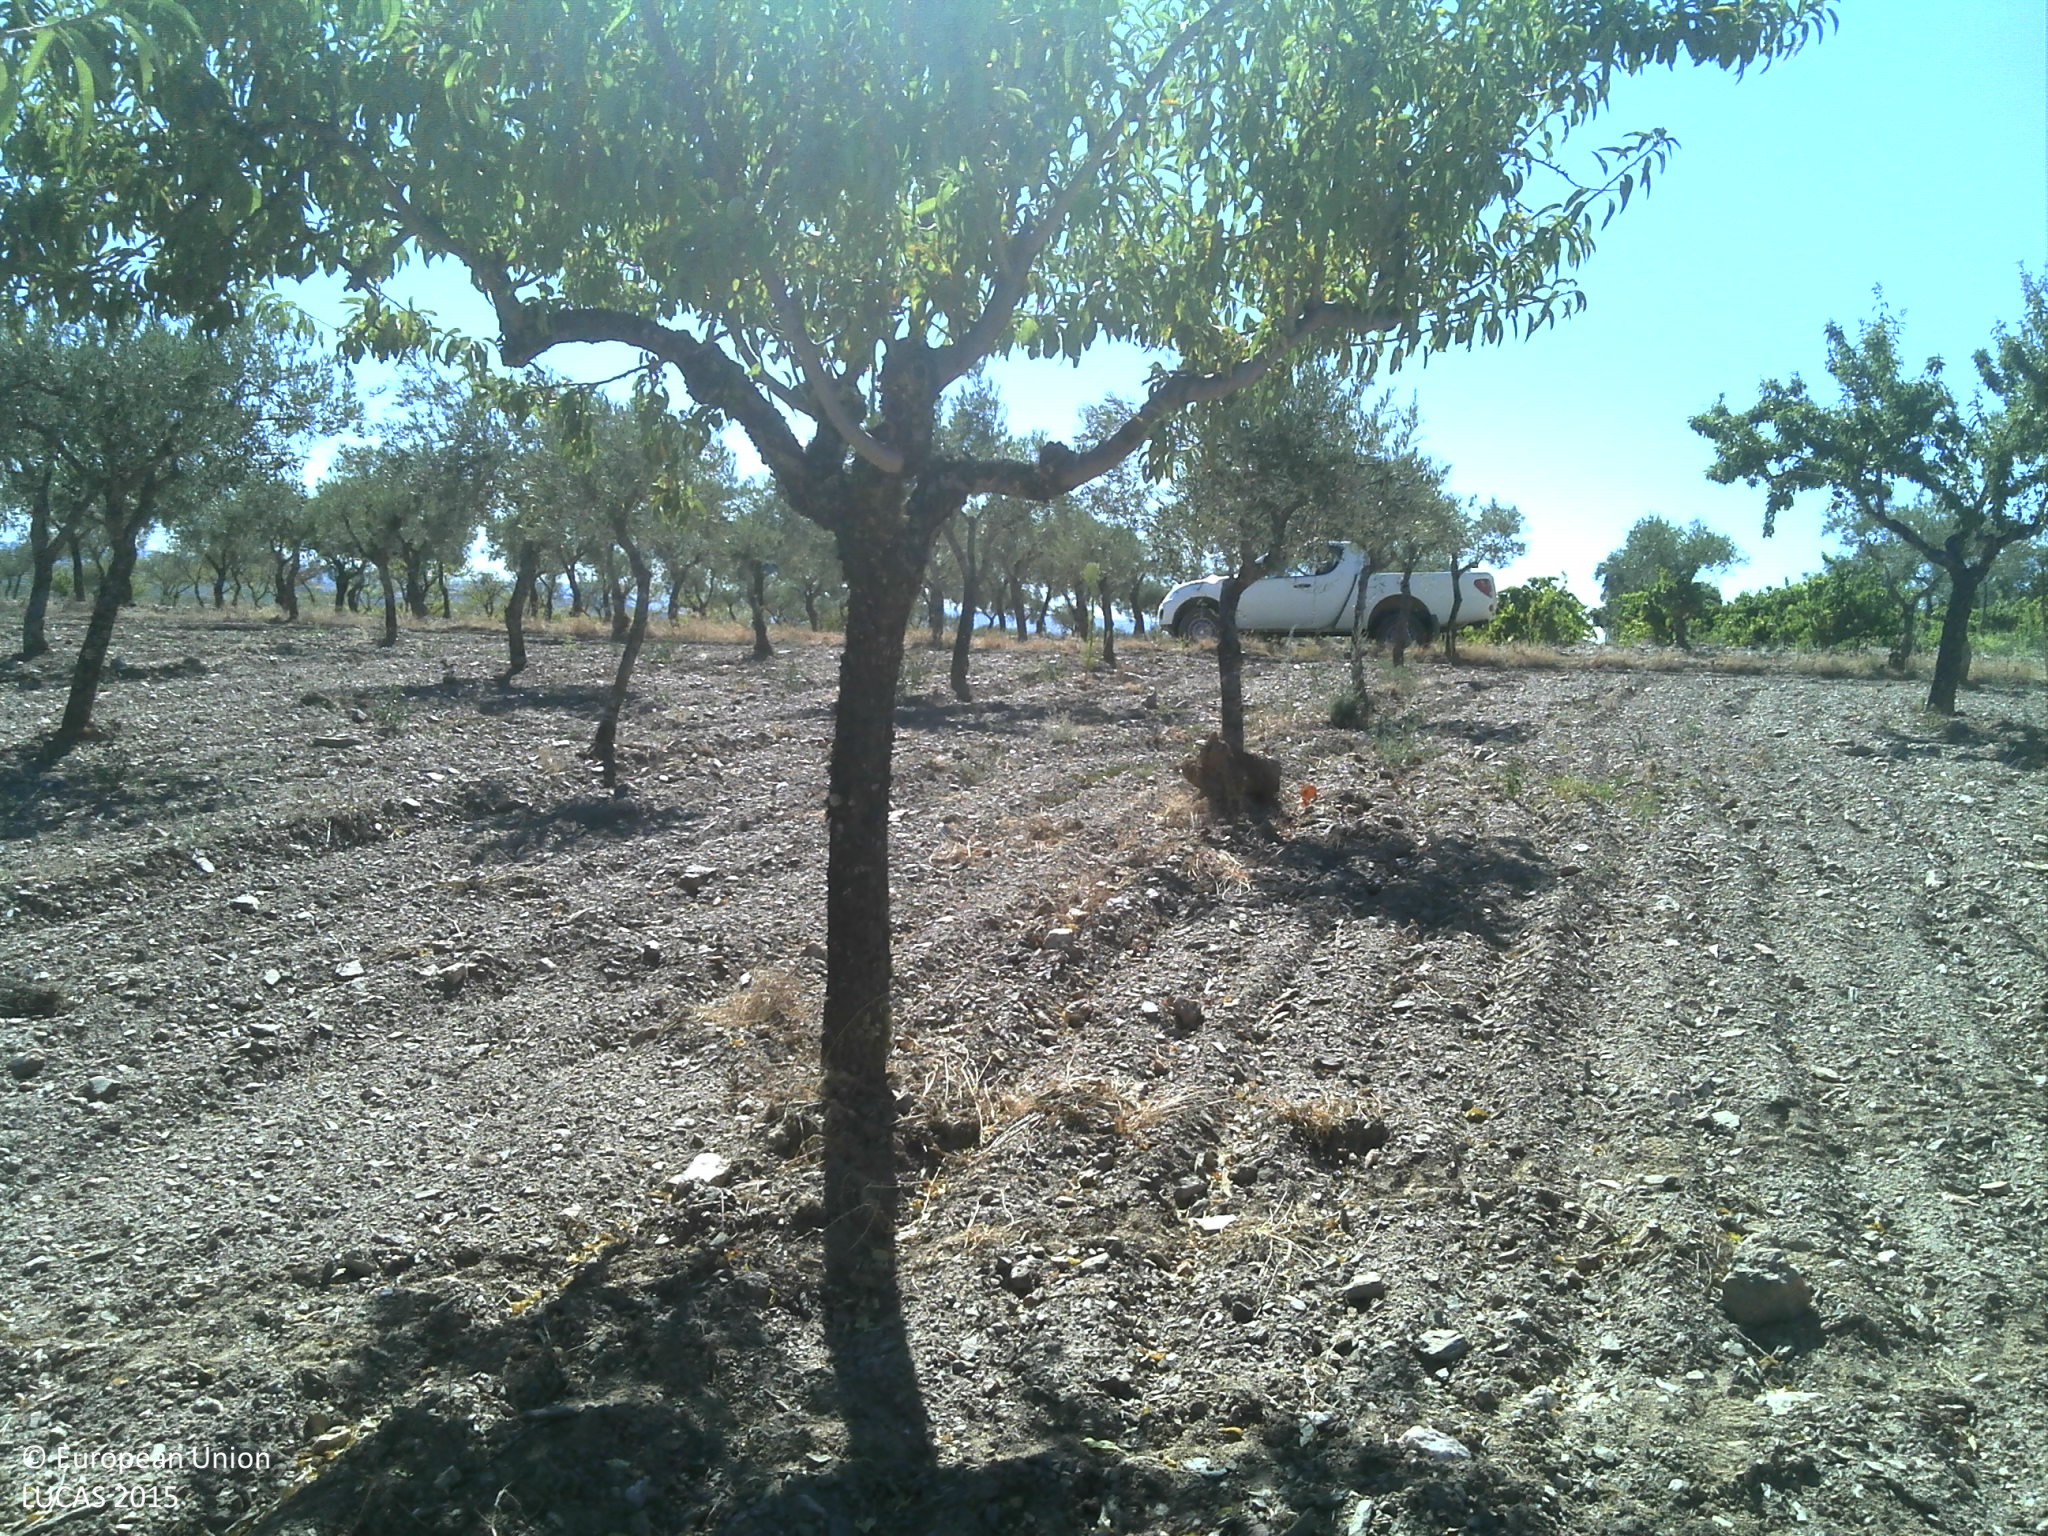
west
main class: Cropland
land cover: Nuts trees
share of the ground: < 10 %
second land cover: Other bare soil
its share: > 75 %
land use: Agriculture (excluding fallow land and kitchen gardens)
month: July
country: PT
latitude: 41.2774
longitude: -7.0045
